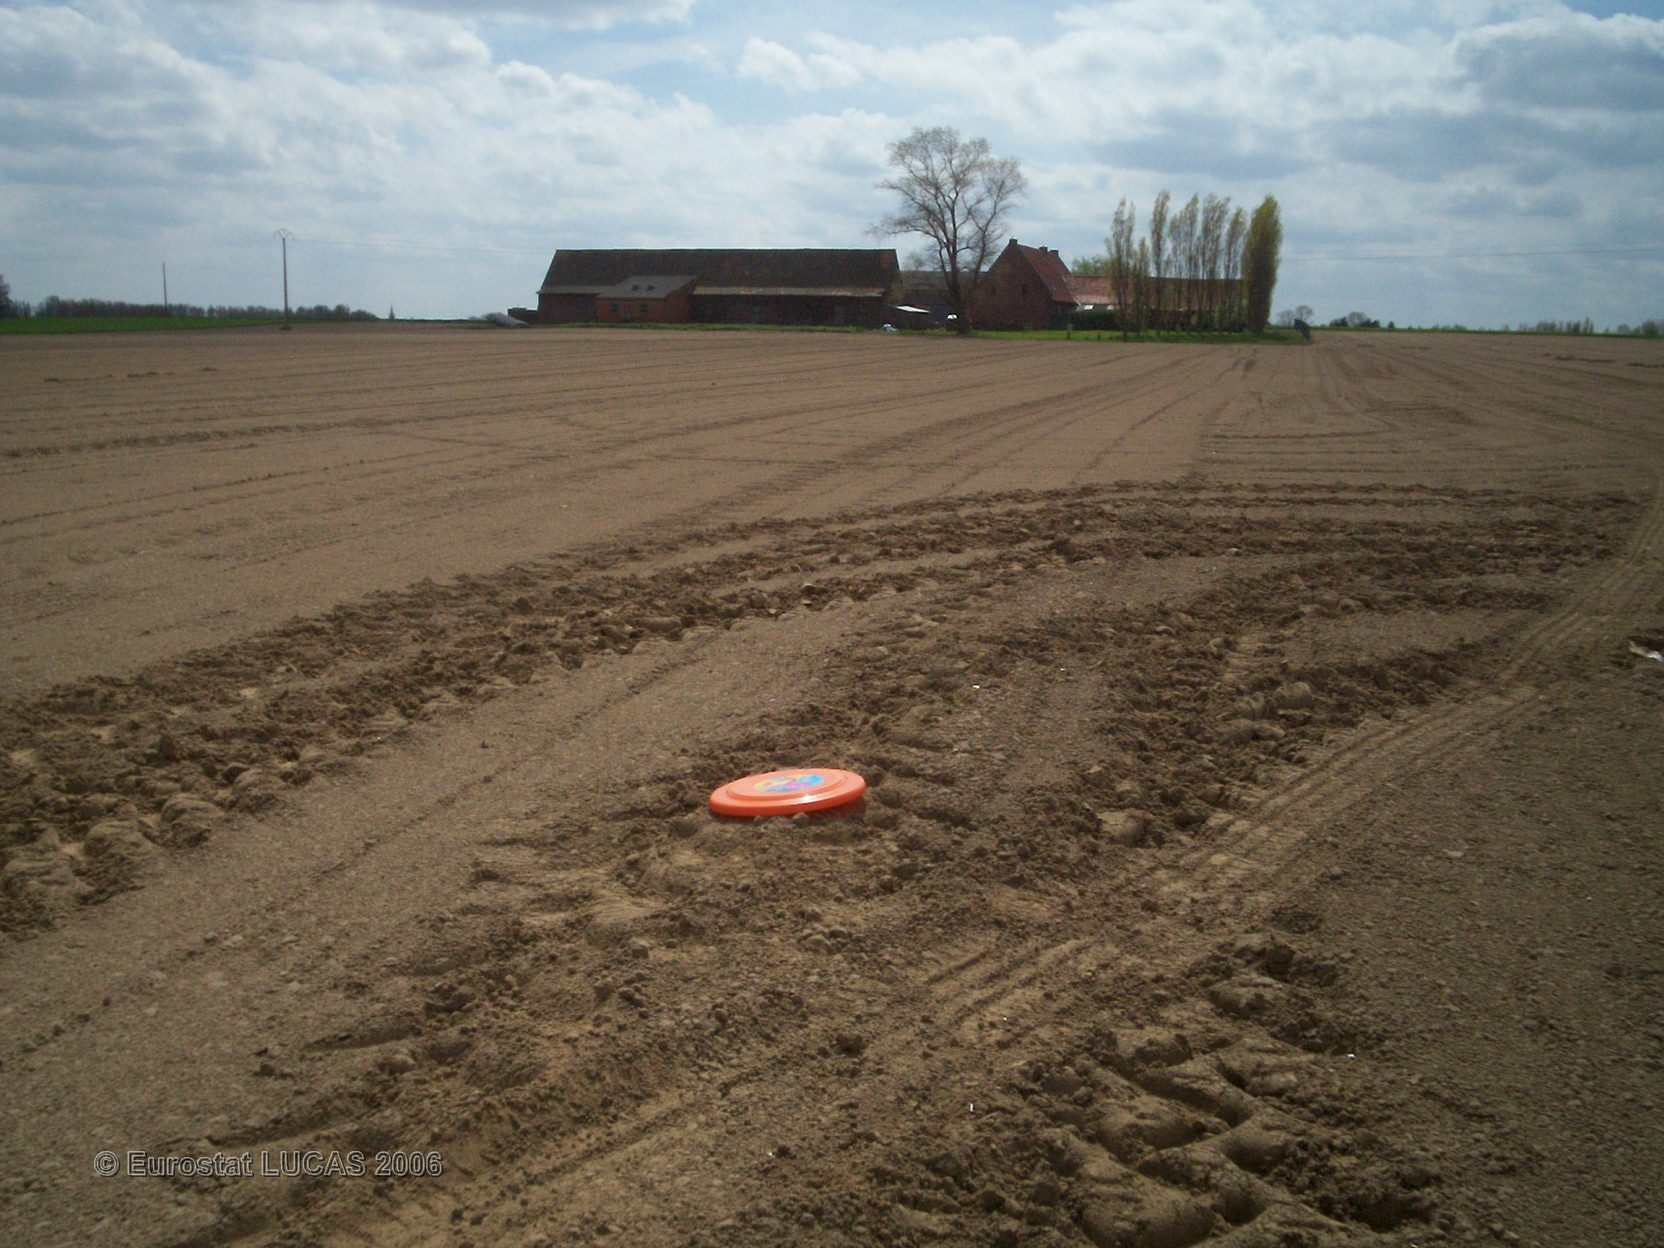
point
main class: Cropland
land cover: Other fresh vegetables
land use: Agriculture (excluding fallow land and kitchen gardens)
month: June
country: FR
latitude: 50.8618
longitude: 2.5571
